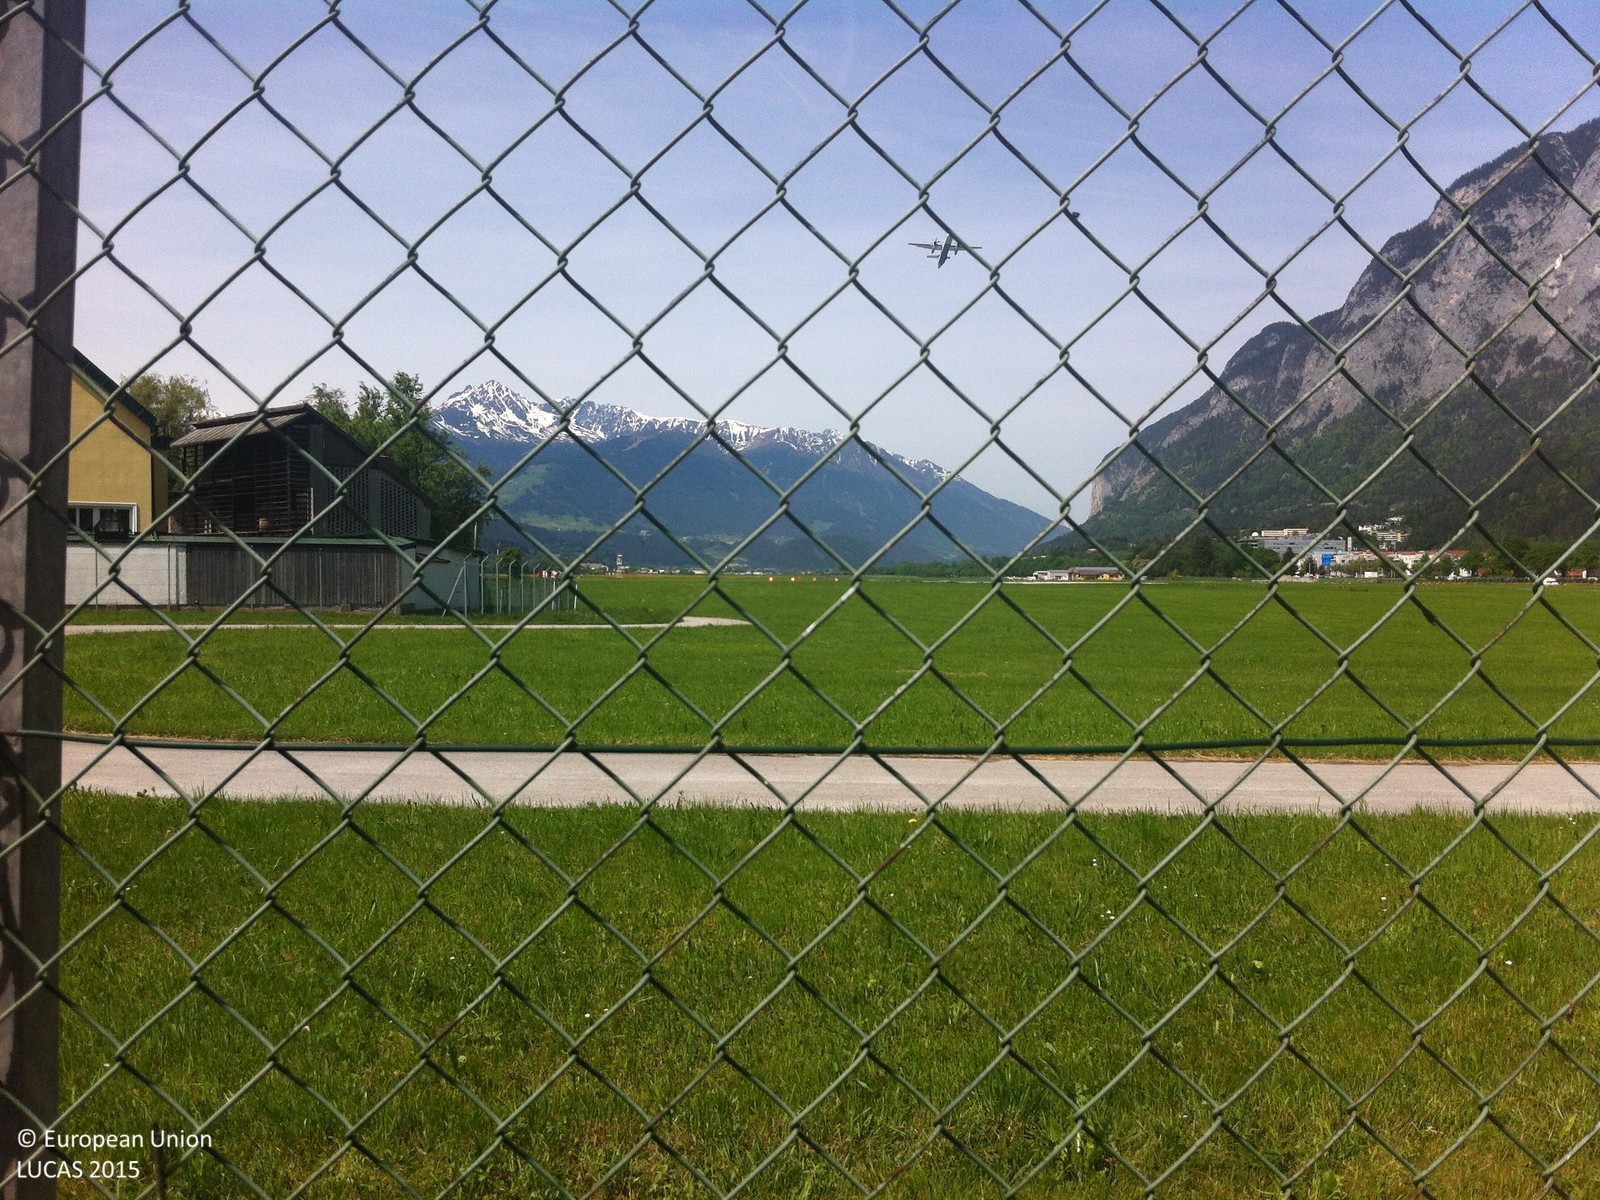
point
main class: Grassland
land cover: Grassland without tree/shrub cover
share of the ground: > 75 %
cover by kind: herbaceous plants 100 %
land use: Air transport
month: May
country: AT
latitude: 47.2611
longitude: 11.3599
